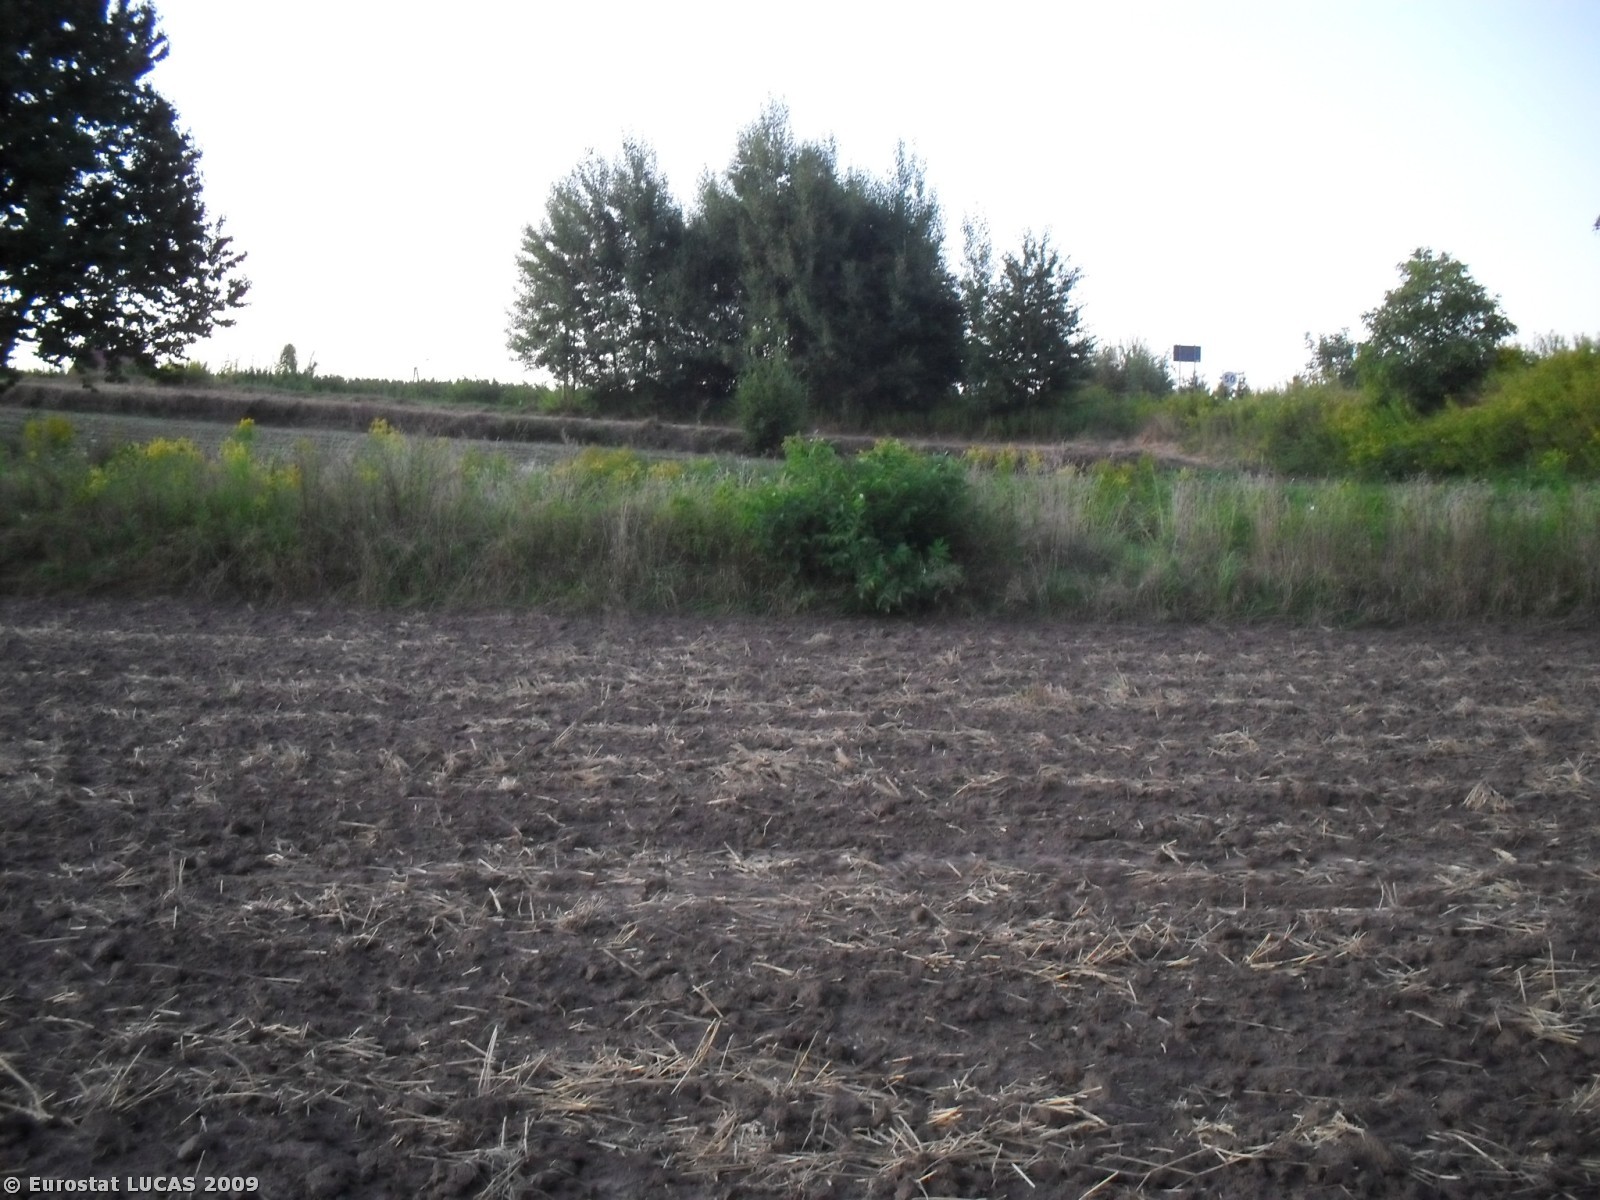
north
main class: Cropland
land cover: Common wheat
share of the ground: < 10 %
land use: Agriculture (excluding fallow land and kitchen gardens)
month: August
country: PL
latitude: 51.3106
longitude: 22.0088
